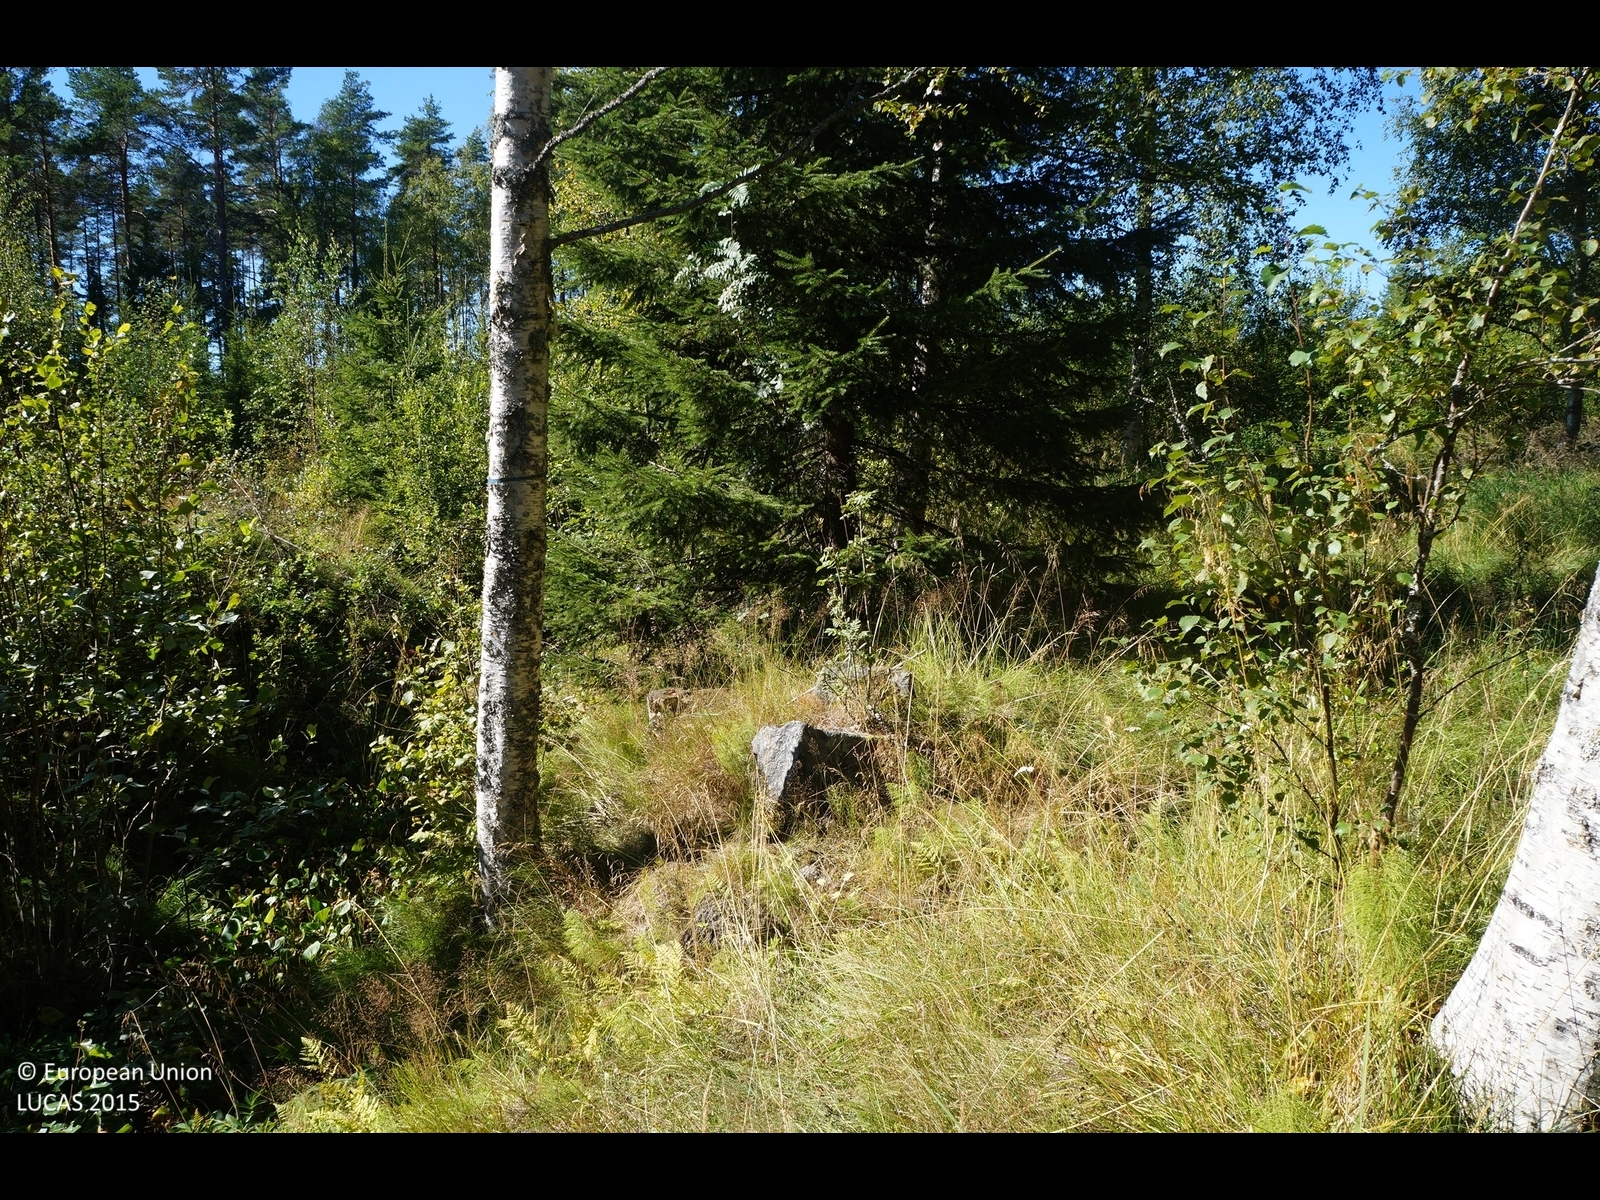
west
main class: Woodland
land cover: Broadleaved woodland
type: boreal forest
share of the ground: 25 - 50 %
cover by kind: herbaceous plants 50 %, broadleaved forest trees 30 %, shrubs 10 %, coniferous forest trees 5 %, lichens and mosses 5 %
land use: Forestry
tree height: > 5 m
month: August
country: FI
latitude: 63.8234
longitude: 22.7874
